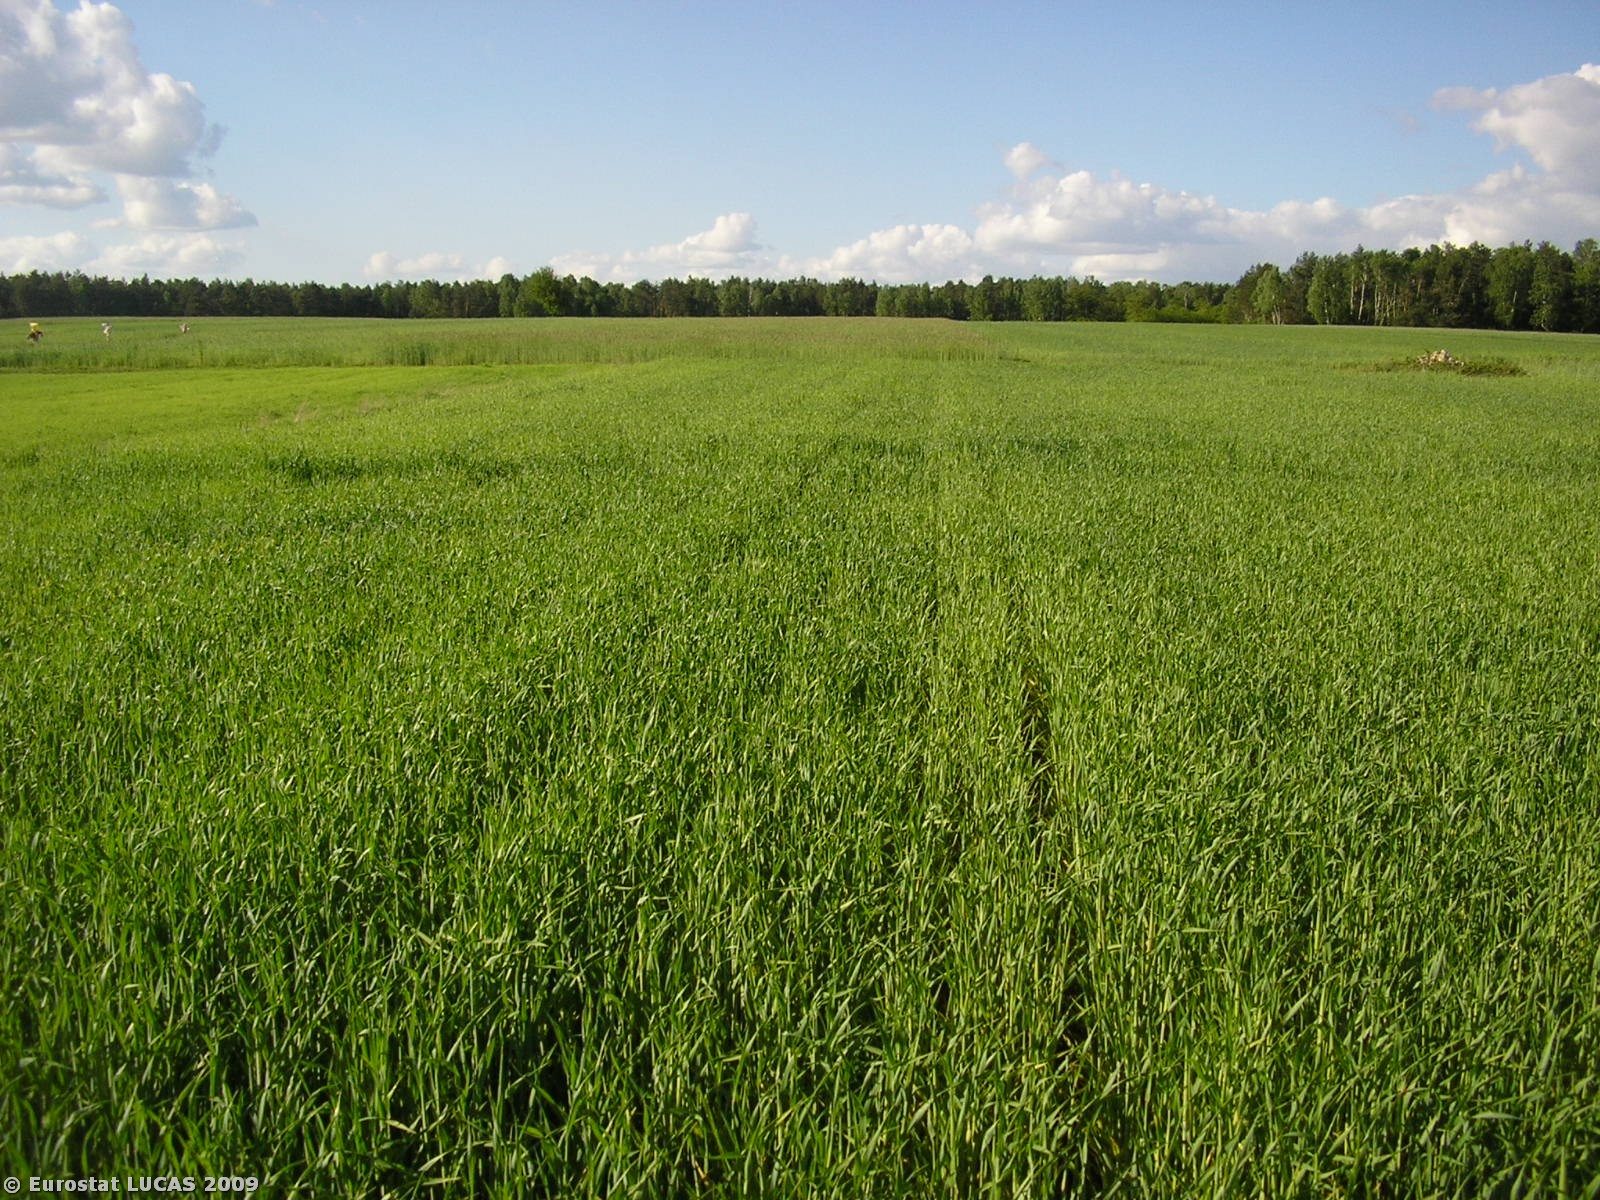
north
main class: Cropland
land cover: Triticale
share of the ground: > 75 %
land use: Agriculture (excluding fallow land and kitchen gardens)
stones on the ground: < 10 %
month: May
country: PL
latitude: 51.9137
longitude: 20.0499
